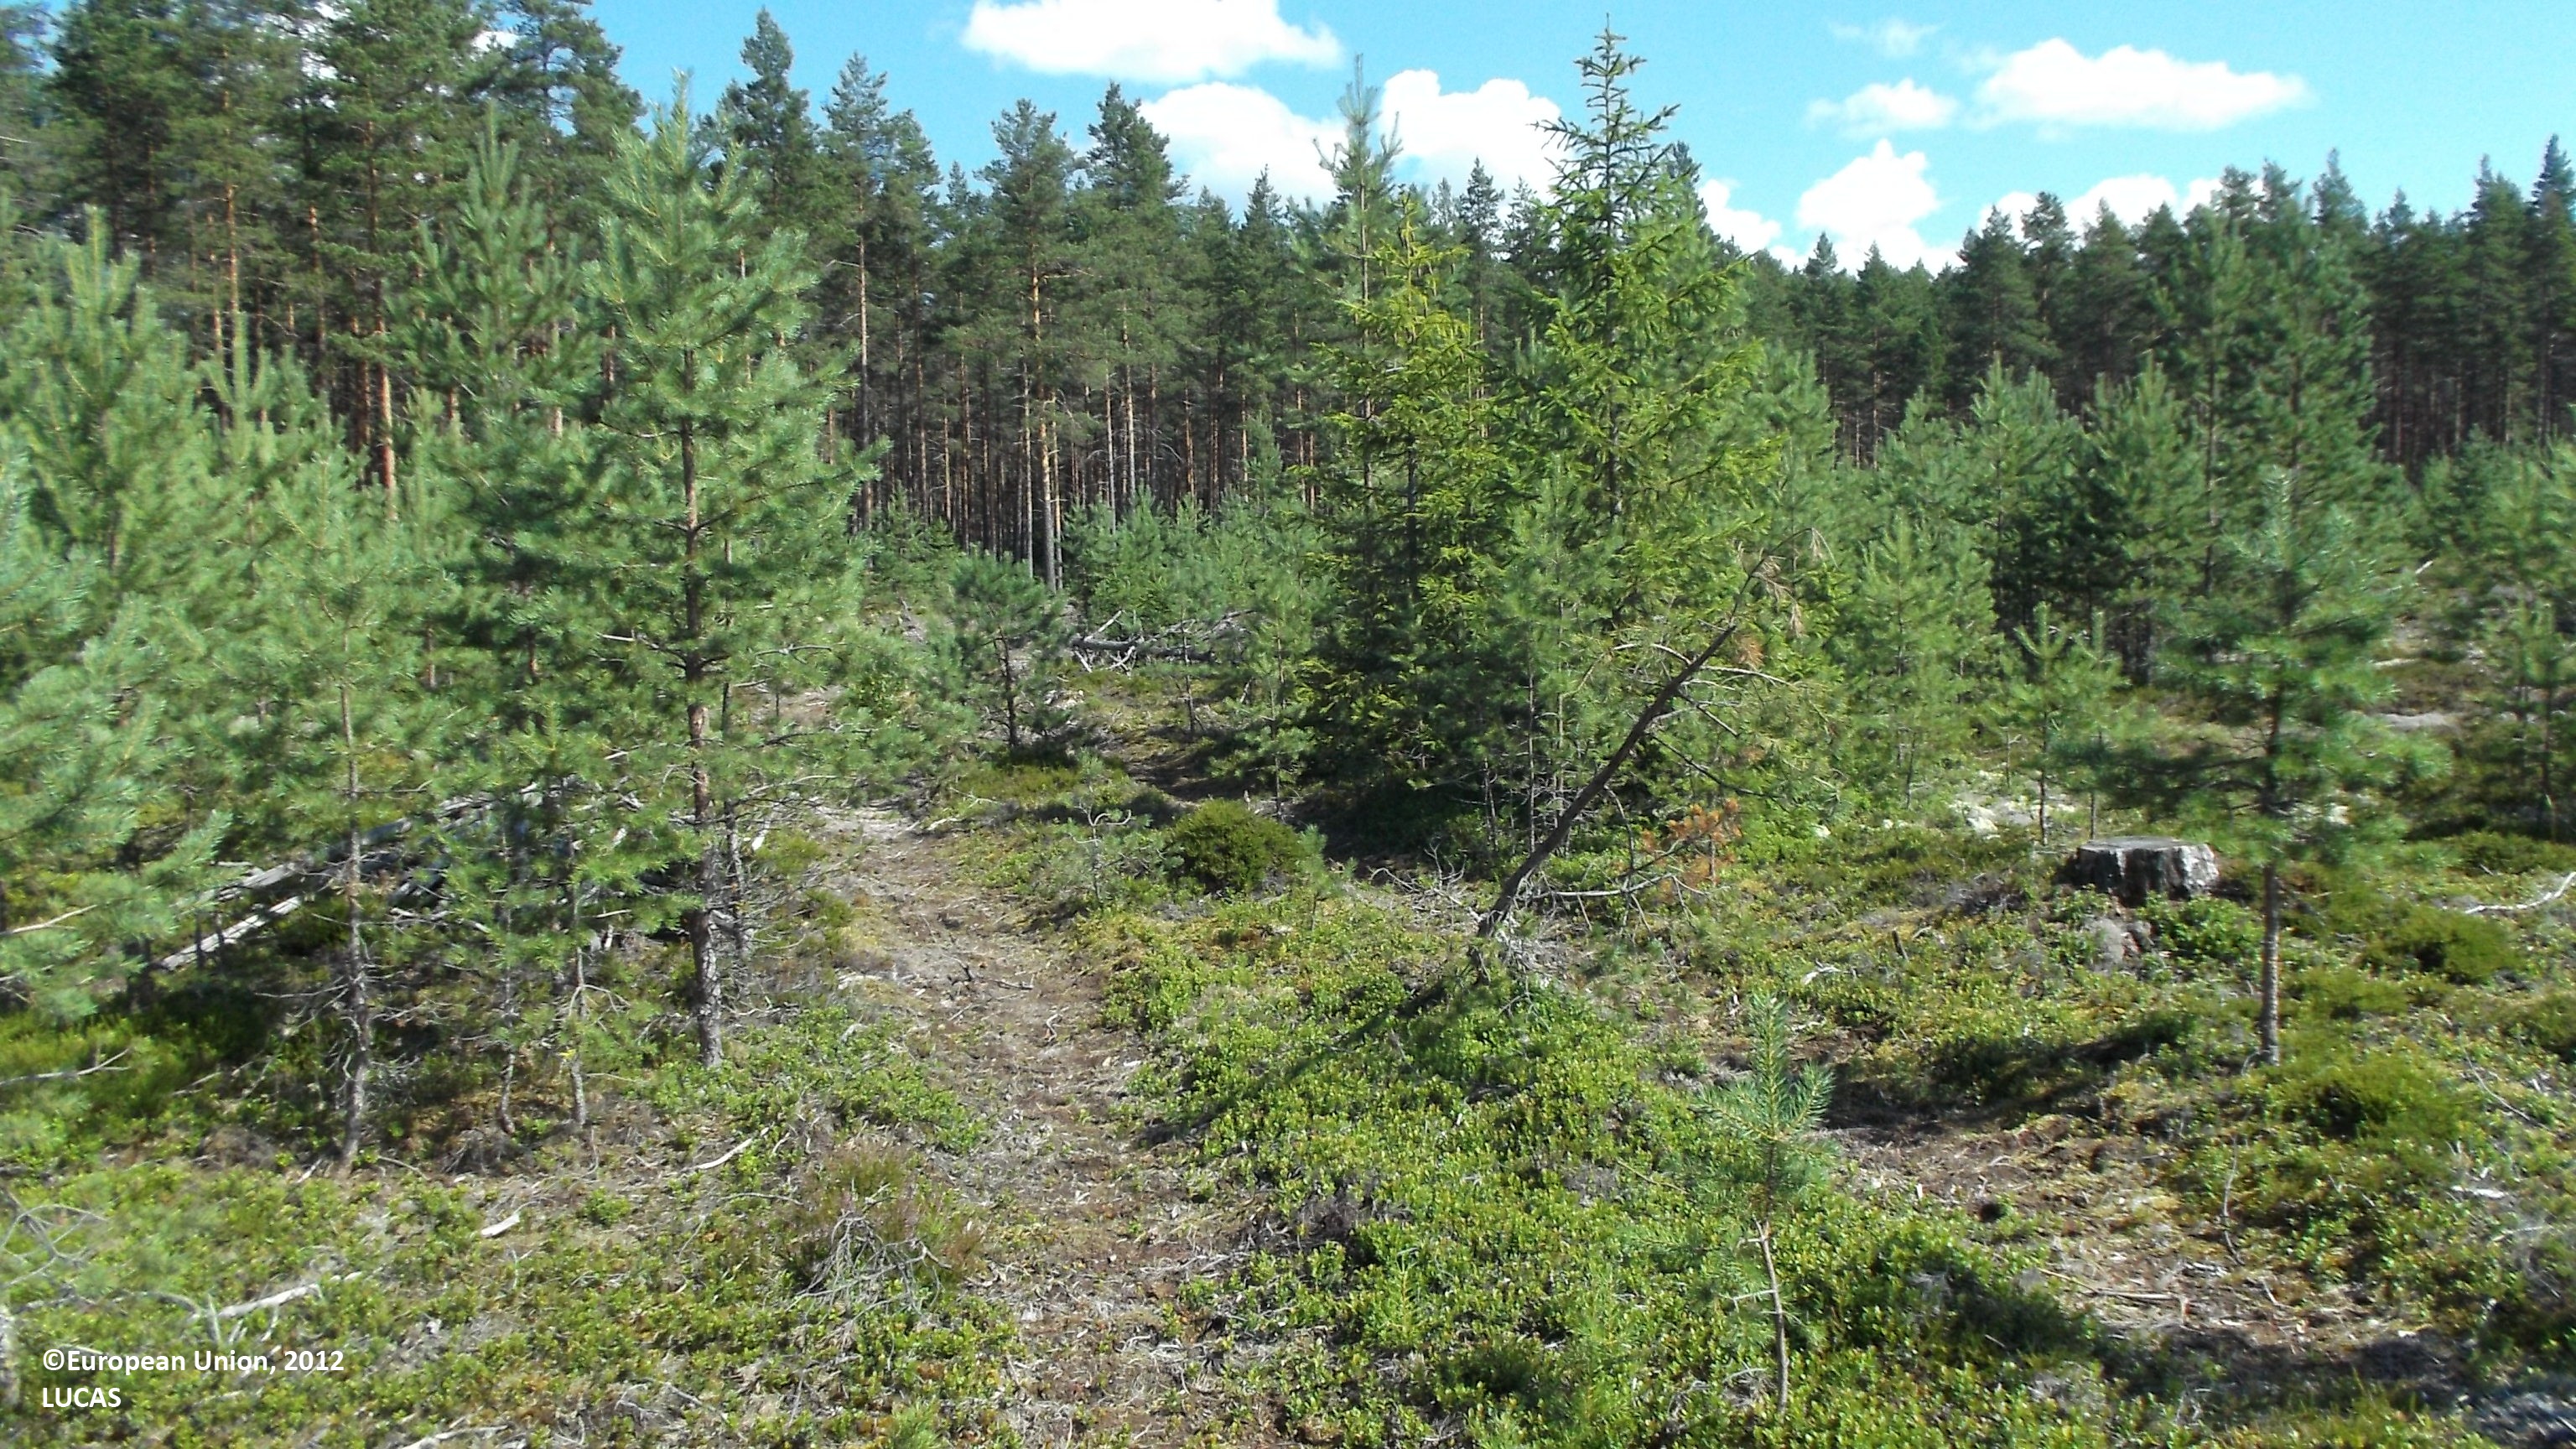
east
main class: Woodland
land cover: Pine dominated coniferous woodland
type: boreal forest
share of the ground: 25 - 50 %
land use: Forestry
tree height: < 5 m
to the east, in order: Pine dominated coniferous woodland; Pine dominated mixed woodland; Tracks; Pine dominated mixed woodland; Pine dominated coniferous woodland; Tracks; Pine dominated coniferous woodland; Tracks; Pine dominated coniferous woodland
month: July
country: FI
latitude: 63.8036
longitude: 23.0256
